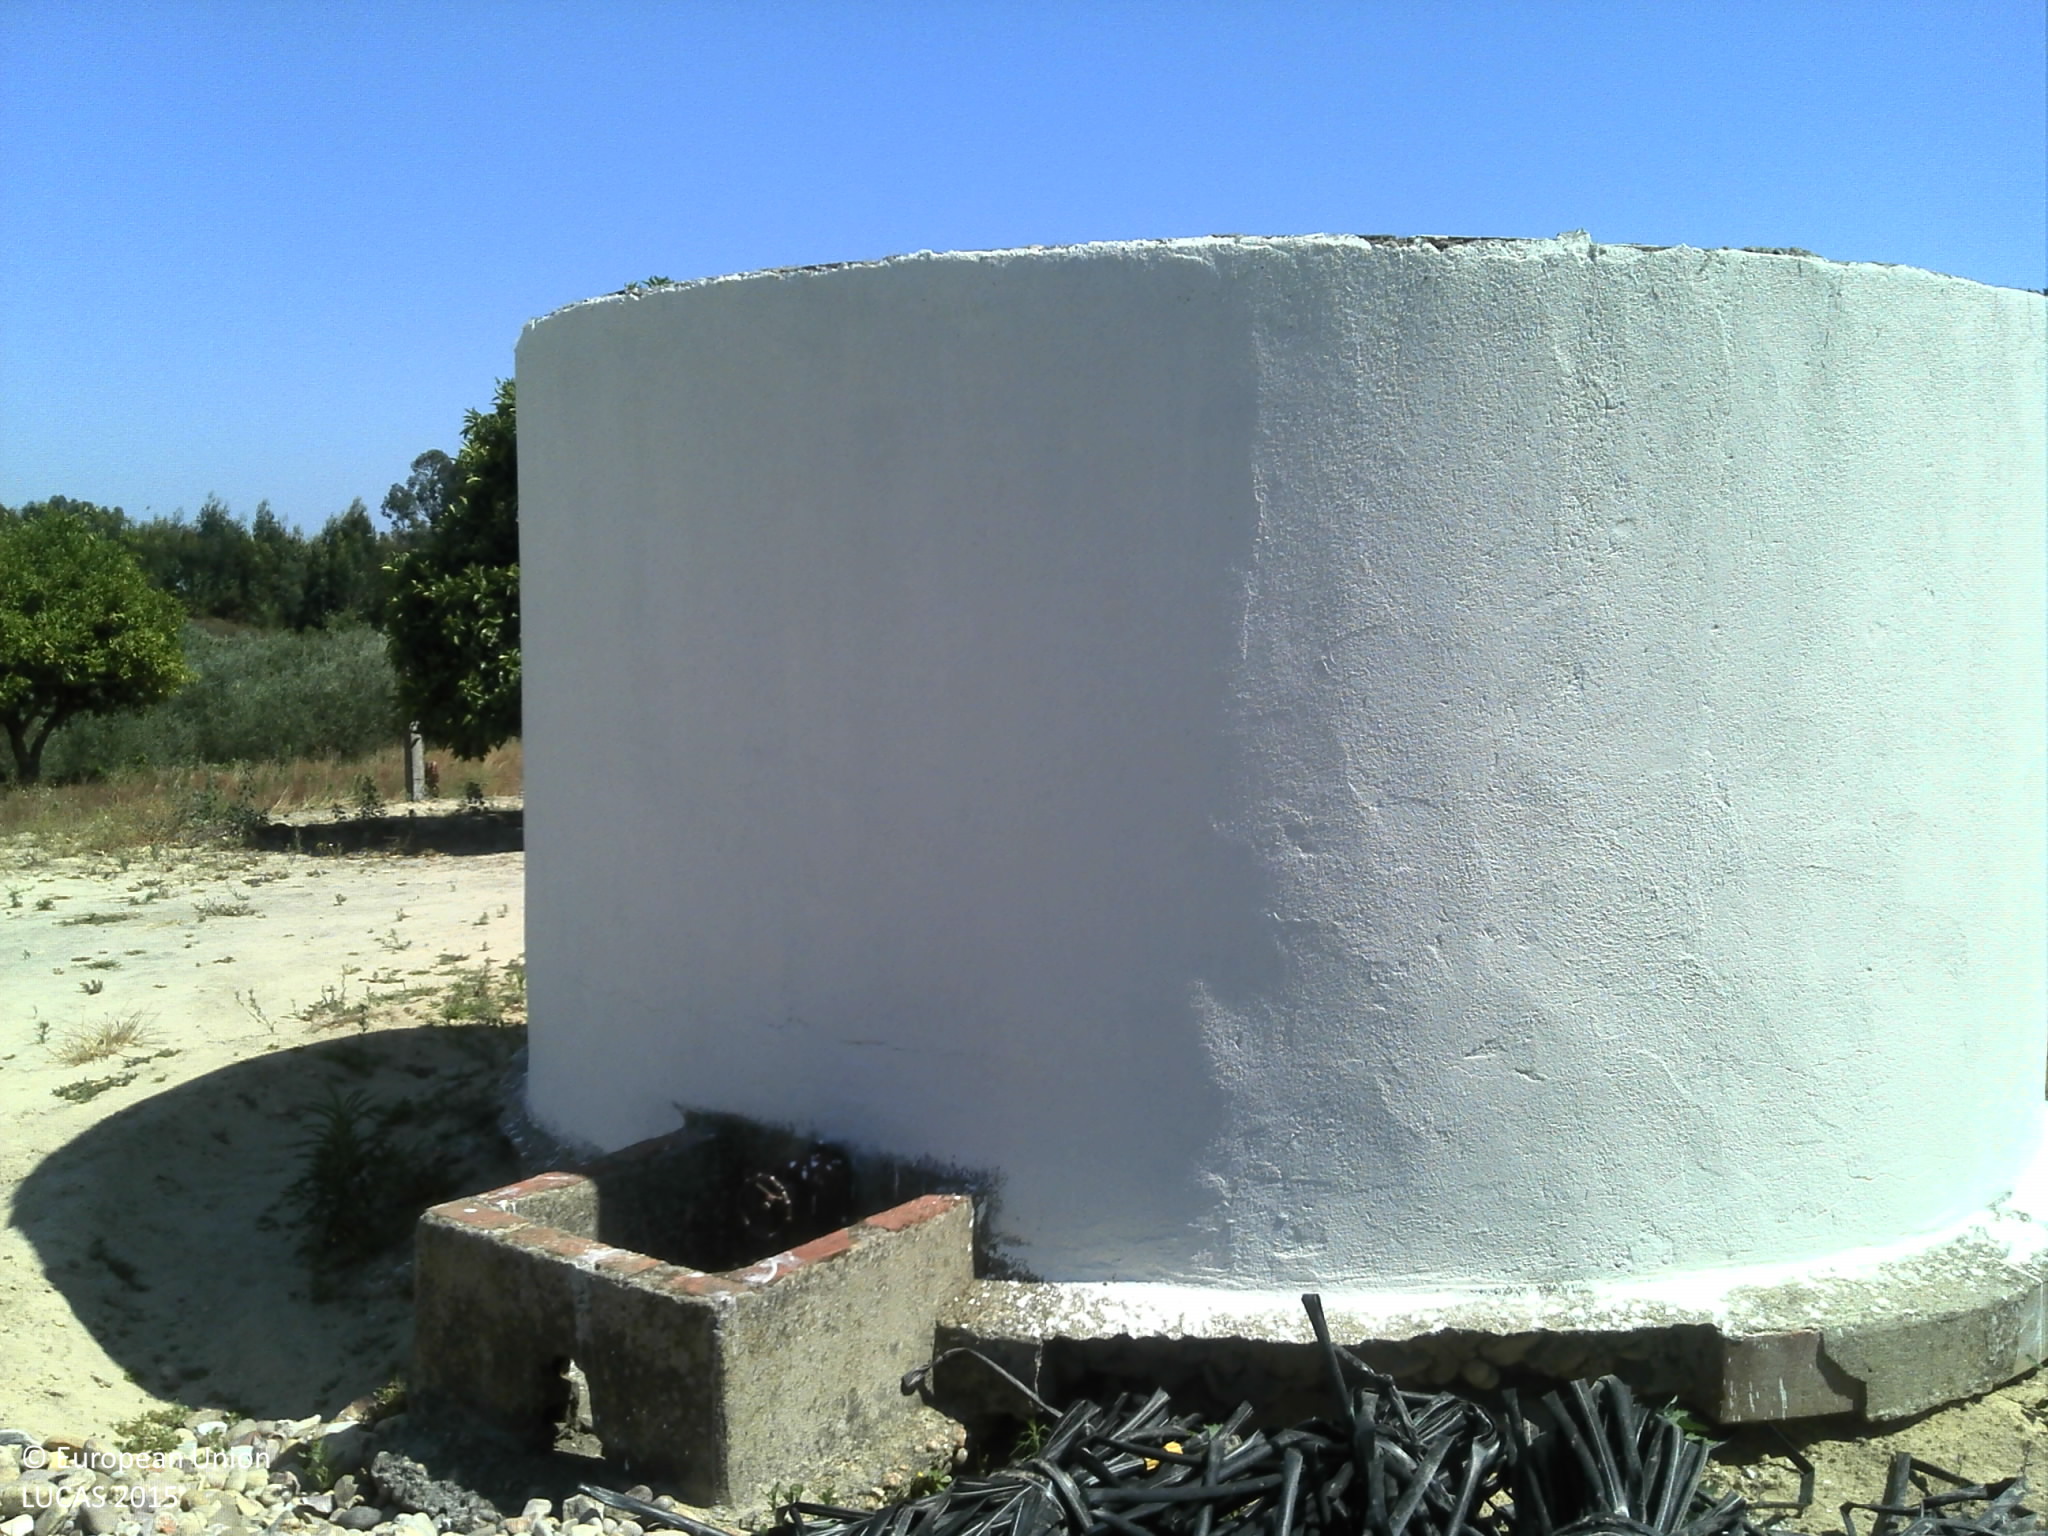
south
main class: Cropland
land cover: Oranges
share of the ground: 50 - 75 %
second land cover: Other bare soil
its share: > 75 %
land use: Agriculture (excluding fallow land and kitchen gardens)
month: June
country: PT
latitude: 39.0470
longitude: -8.6829
